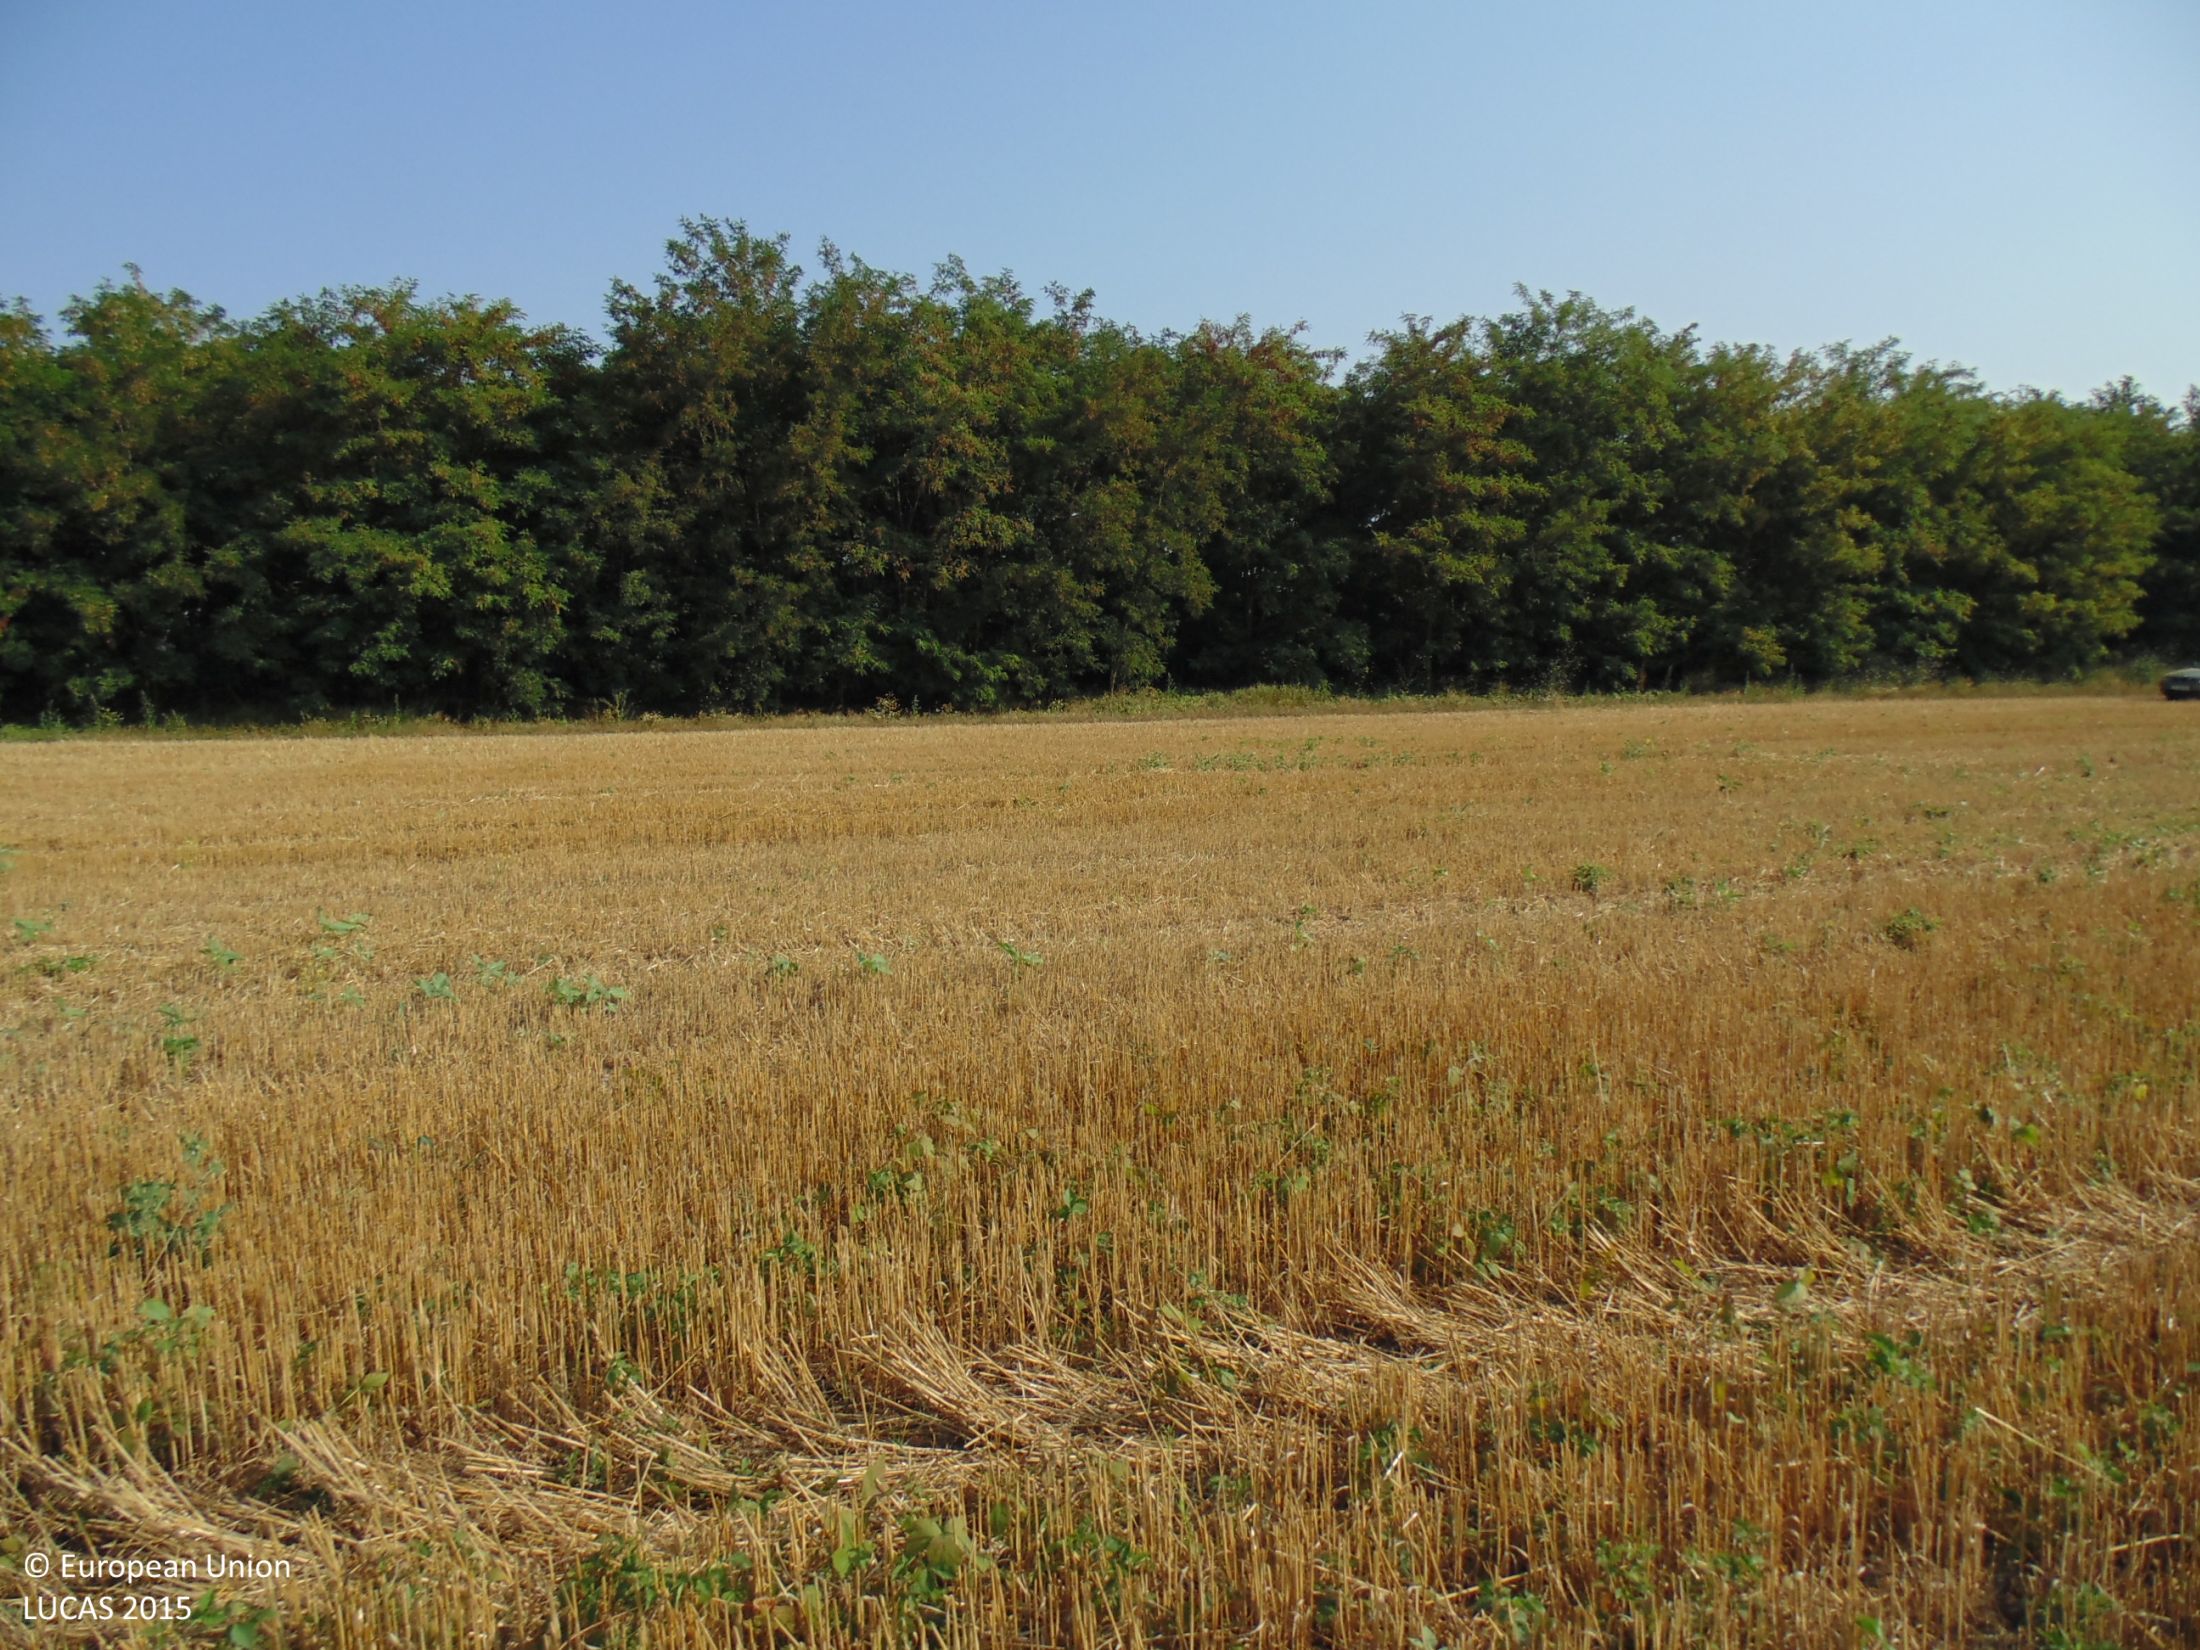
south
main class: Cropland
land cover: Common wheat
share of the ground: 25 - 50 %
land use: Agriculture (excluding fallow land and kitchen gardens)
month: July
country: BG
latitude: 43.5740
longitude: 27.9896
